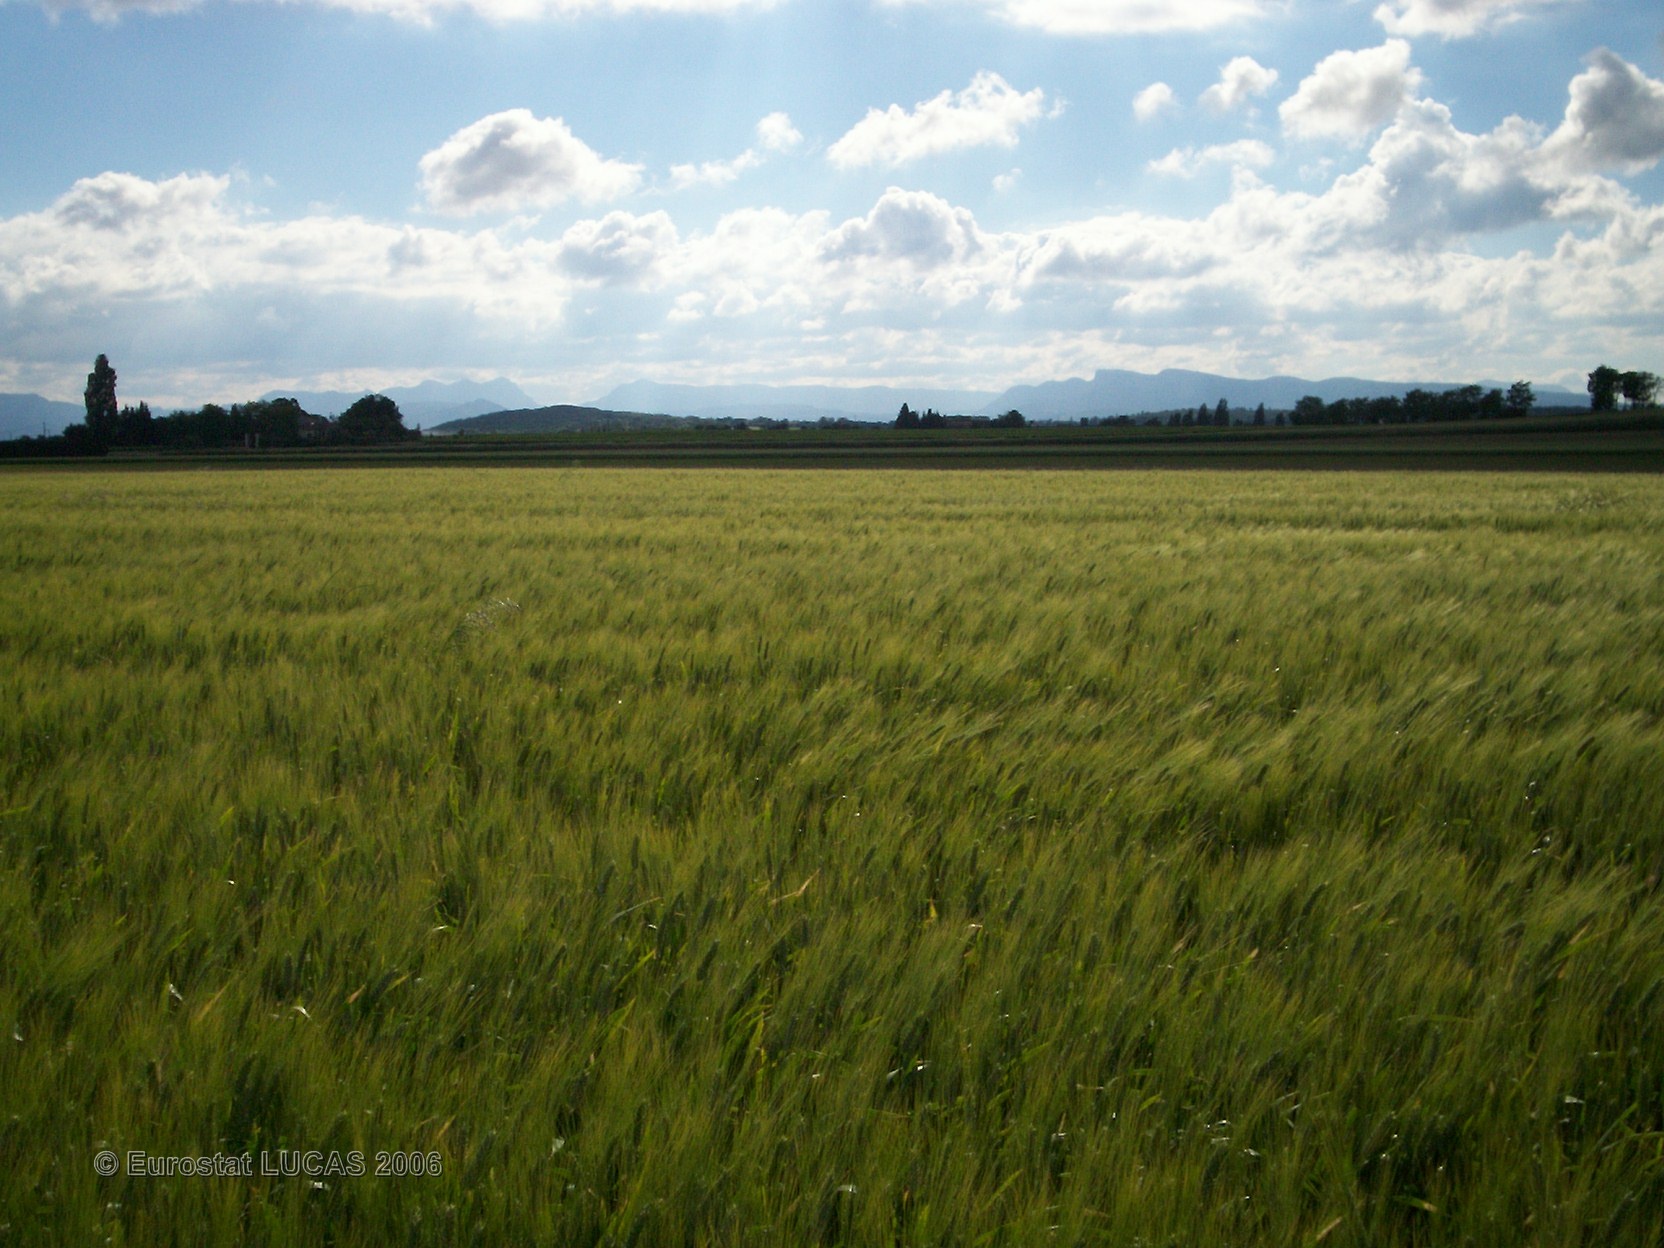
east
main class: Cropland
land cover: Durum wheat
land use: Agriculture (excluding fallow land and kitchen gardens)
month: May
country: FR
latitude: 44.5831
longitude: 4.8302
